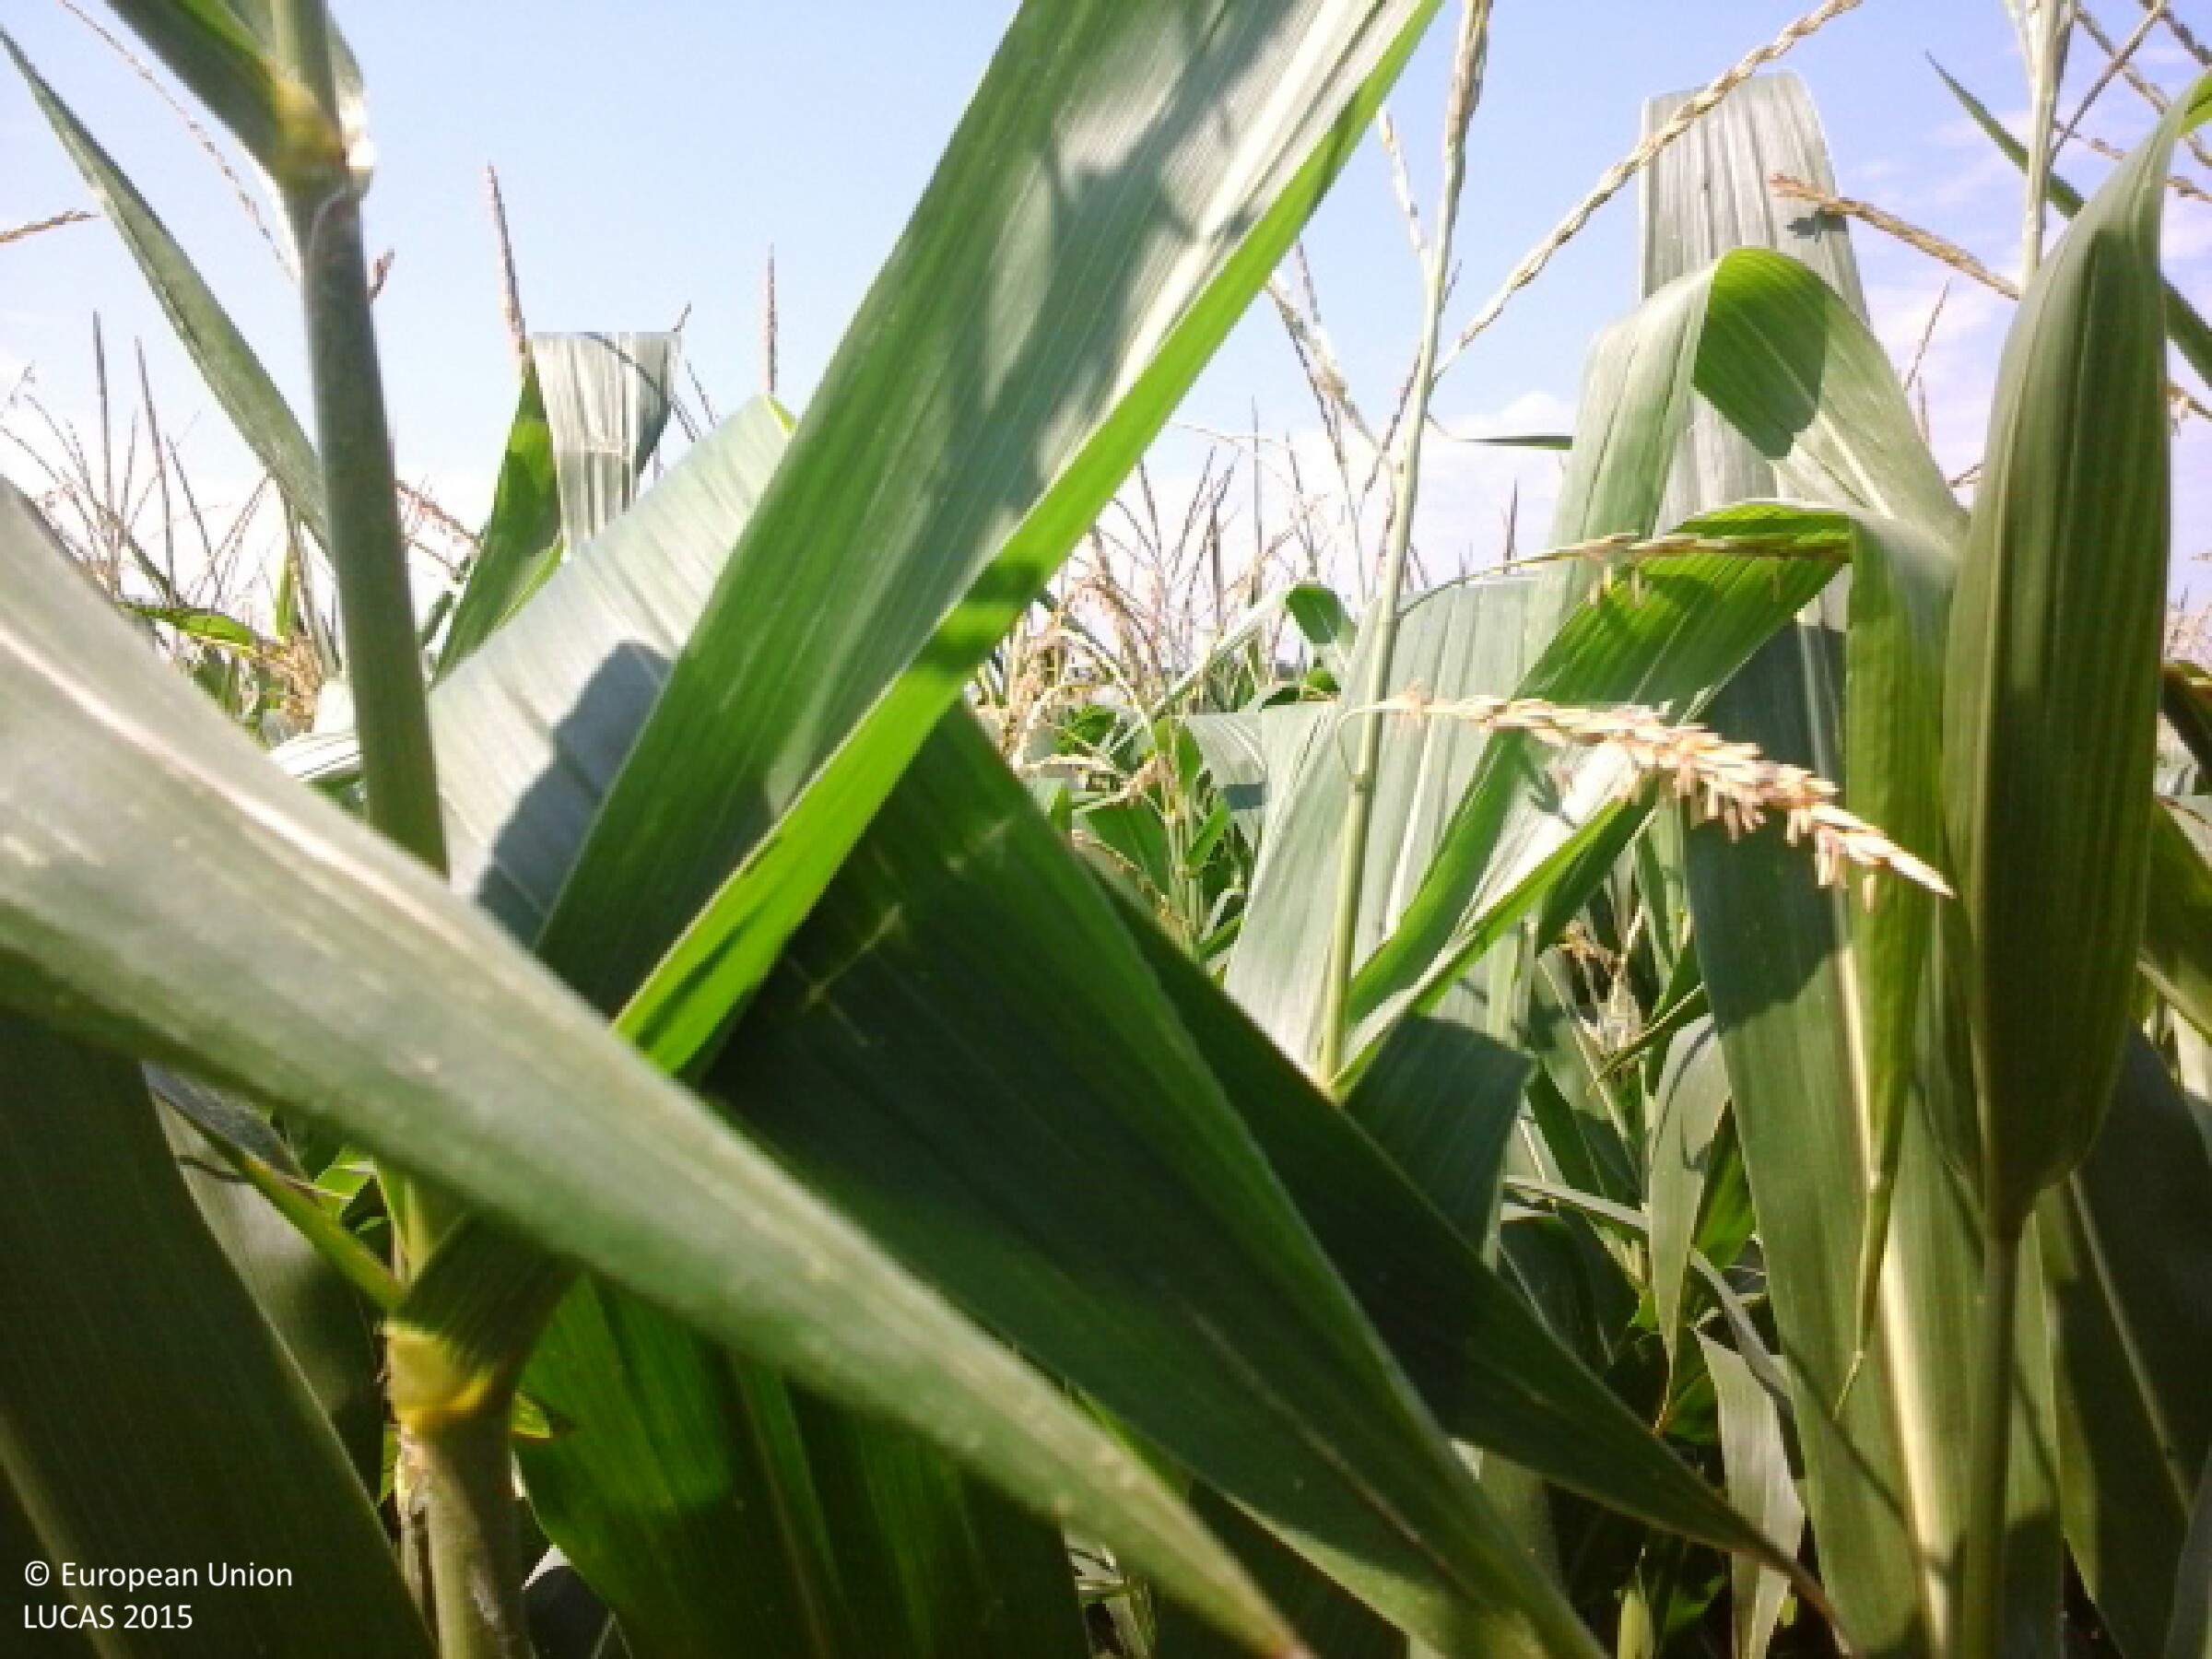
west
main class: Cropland
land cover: Maize
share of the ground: > 75 %
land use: Agriculture (excluding fallow land and kitchen gardens)
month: July
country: HU
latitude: 48.3492
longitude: 21.1200
